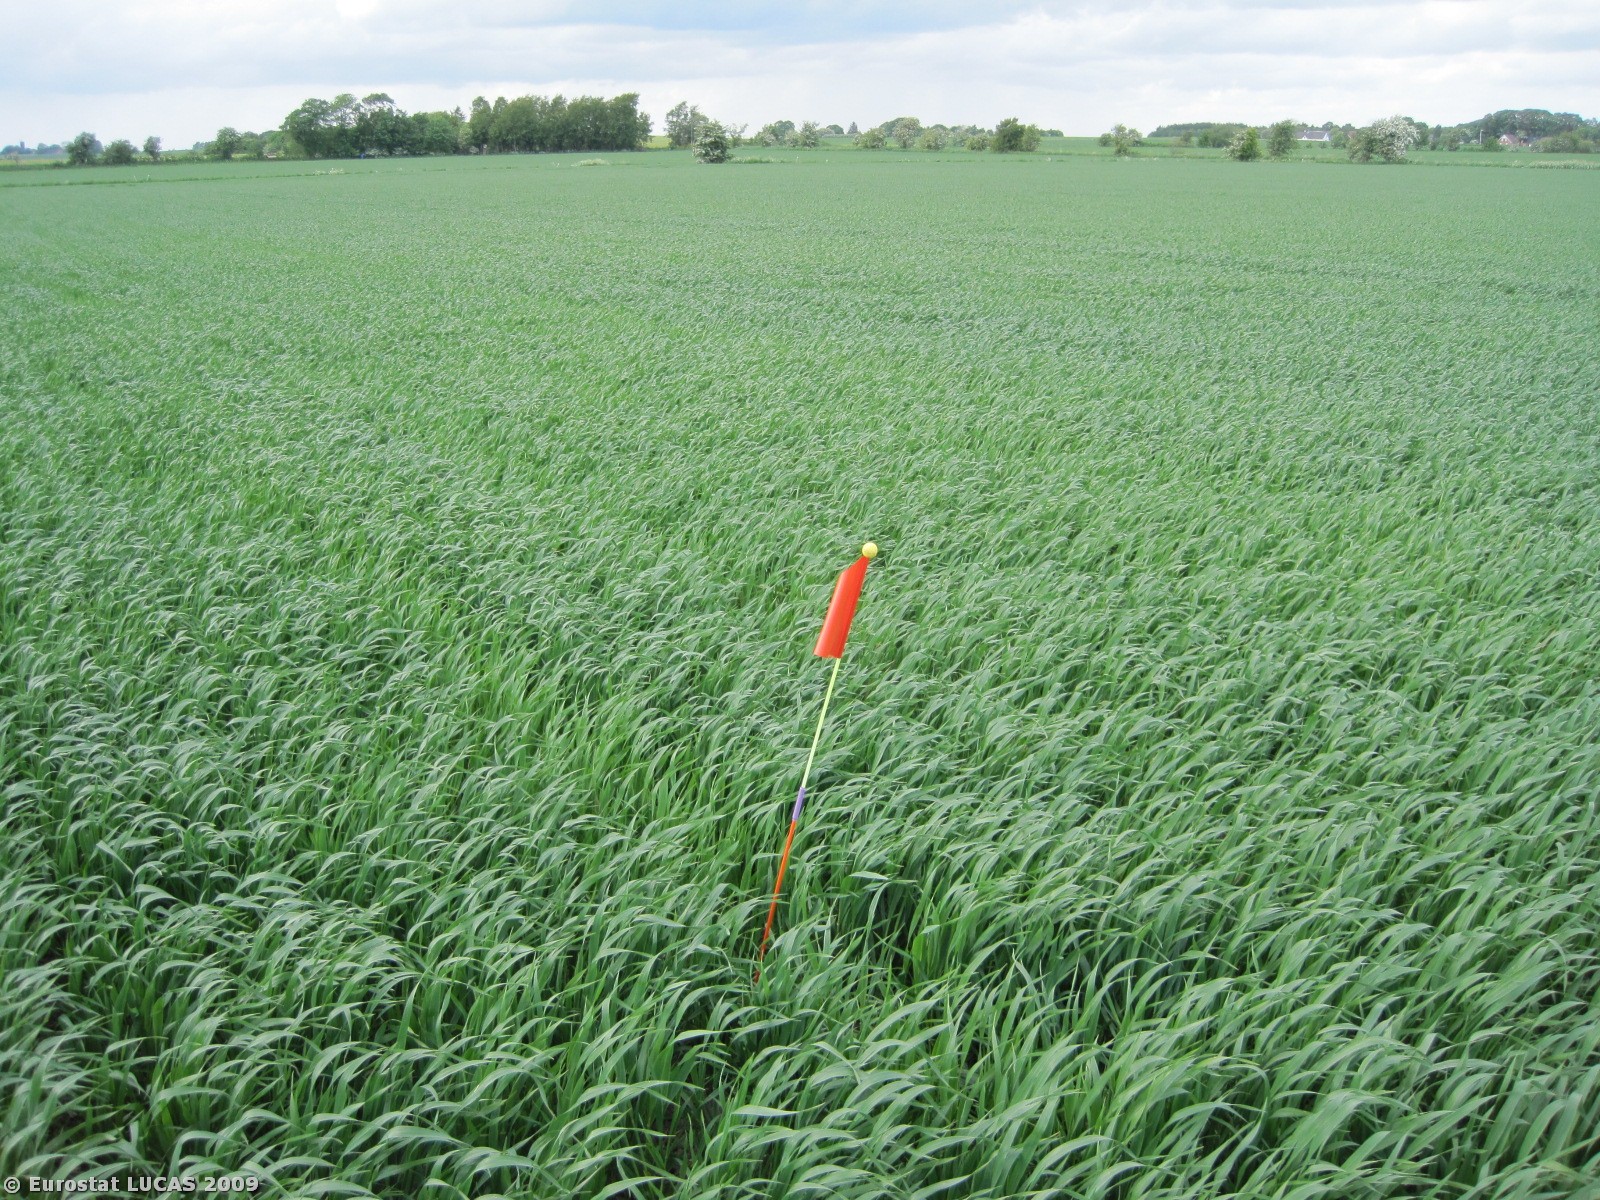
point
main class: Cropland
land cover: Oats
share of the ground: > 75 %
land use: Agriculture (excluding fallow land and kitchen gardens)
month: May
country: DK
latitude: 56.5113
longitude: 10.0487
